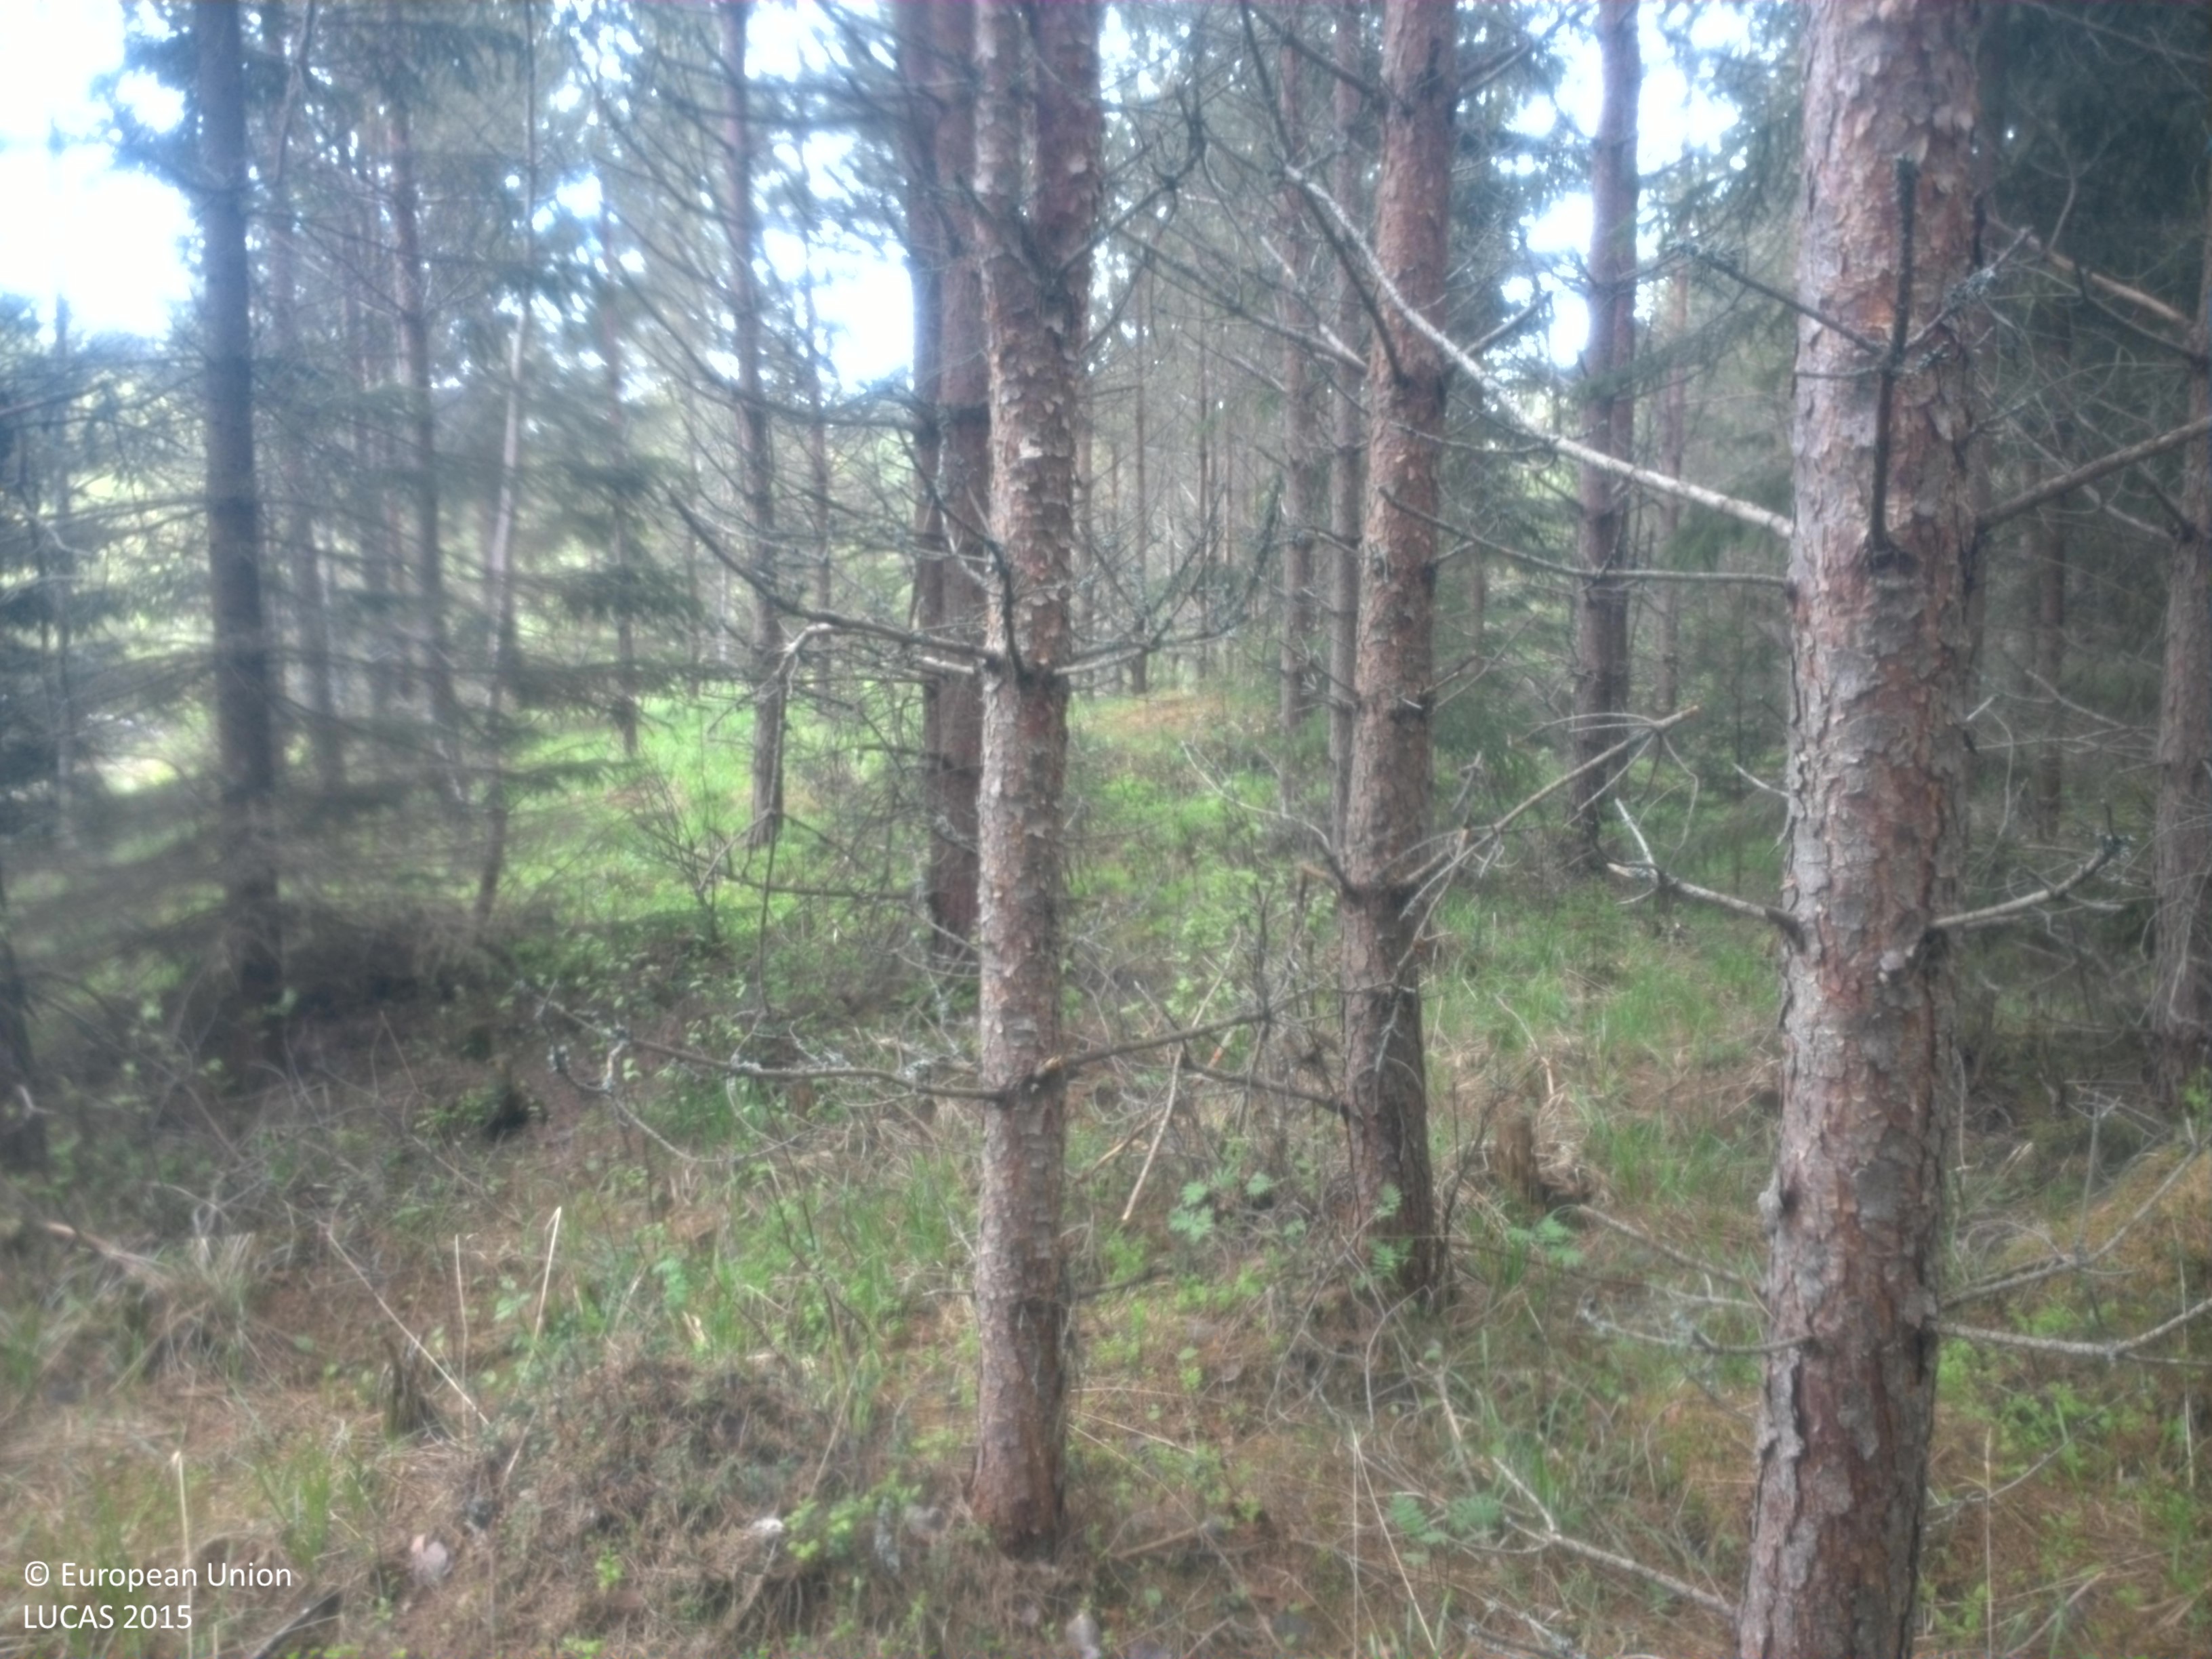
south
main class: Woodland
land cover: Pine dominated coniferous woodland
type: boreal forest
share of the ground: 25 - 50 %
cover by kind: coniferous forest trees 45 %, shrubs 30 %, herbaceous plants 10 %, lichens and mosses 10 %, broadleaved forest trees 5 %
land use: Forestry
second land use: Amenities, museums, leisure
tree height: > 5 m
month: May
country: SE
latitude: 59.5843
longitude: 12.3844
